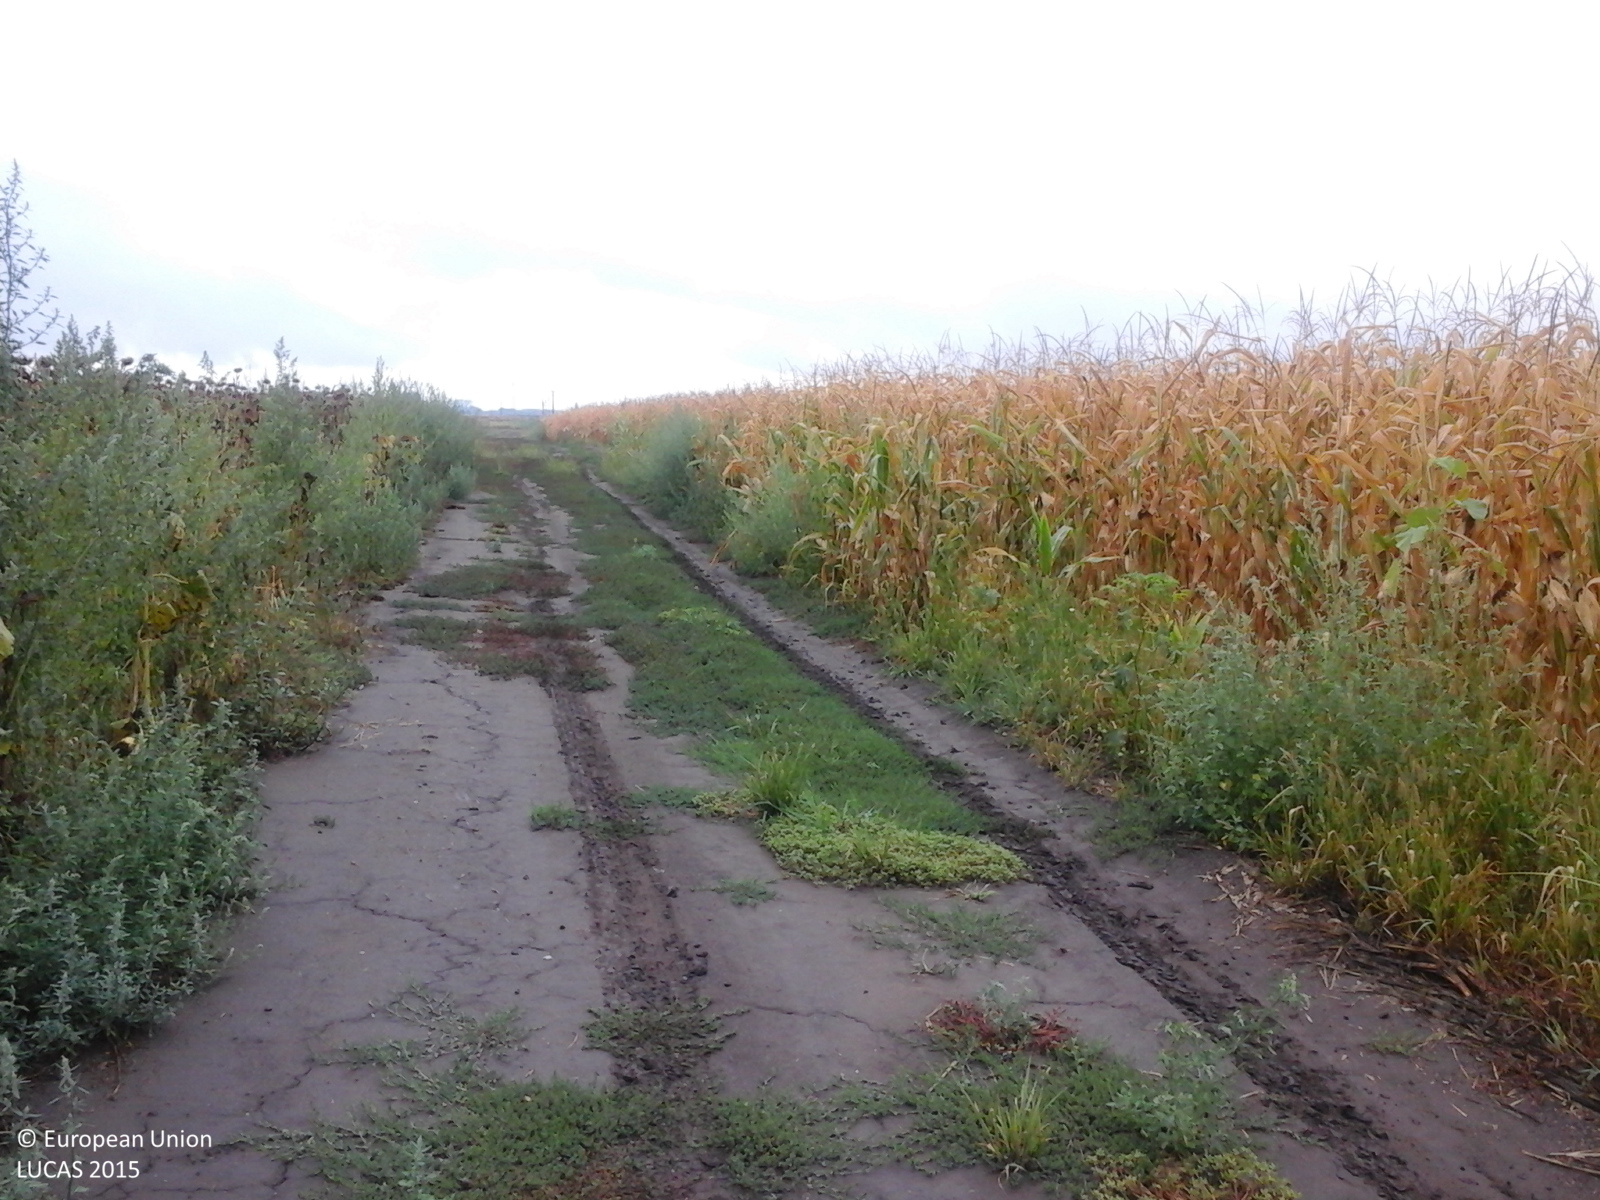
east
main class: Cropland
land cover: Sunflower
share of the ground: > 75 %
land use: Agriculture (excluding fallow land and kitchen gardens)
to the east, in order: Sunflower; Common wheat
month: August
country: RO
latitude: 45.9738
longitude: 20.7256
